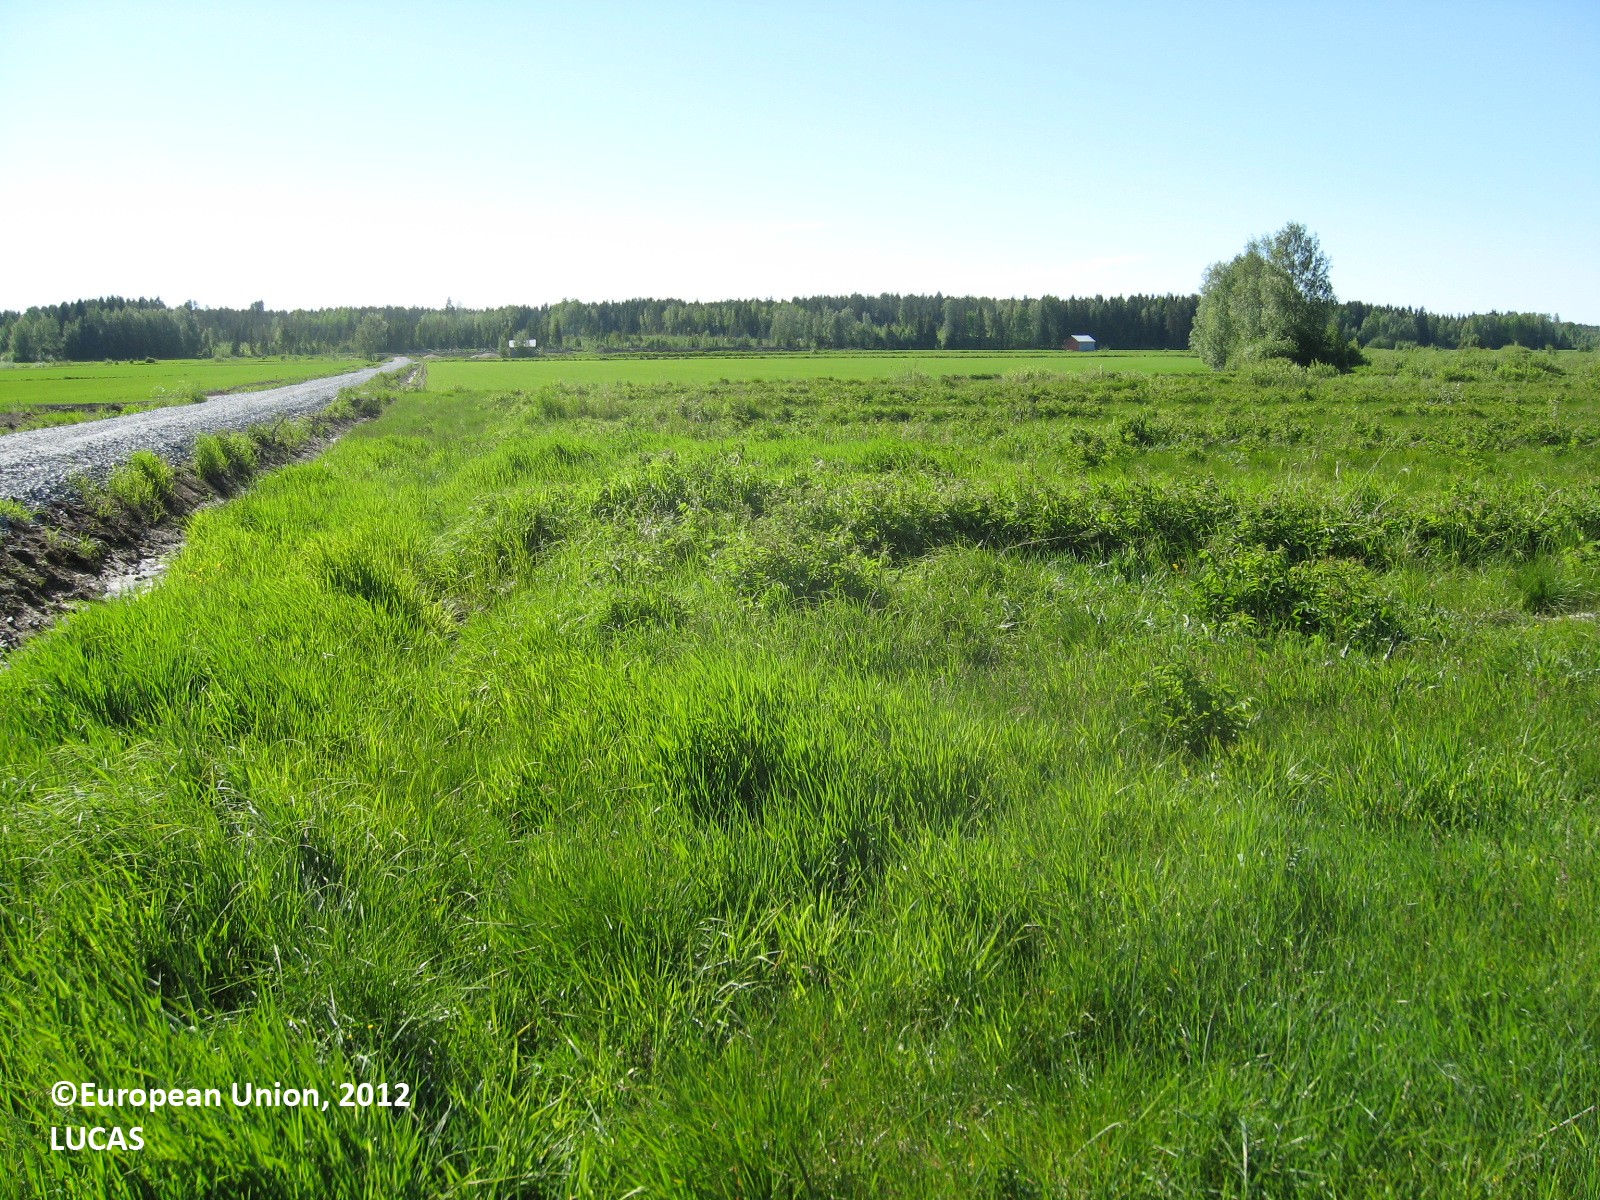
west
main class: Grassland
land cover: Grassland without tree/shrub cover
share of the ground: > 75 %
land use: Agriculture (excluding fallow land and kitchen gardens)
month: June
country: FI
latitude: 63.2942
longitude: 22.7573
